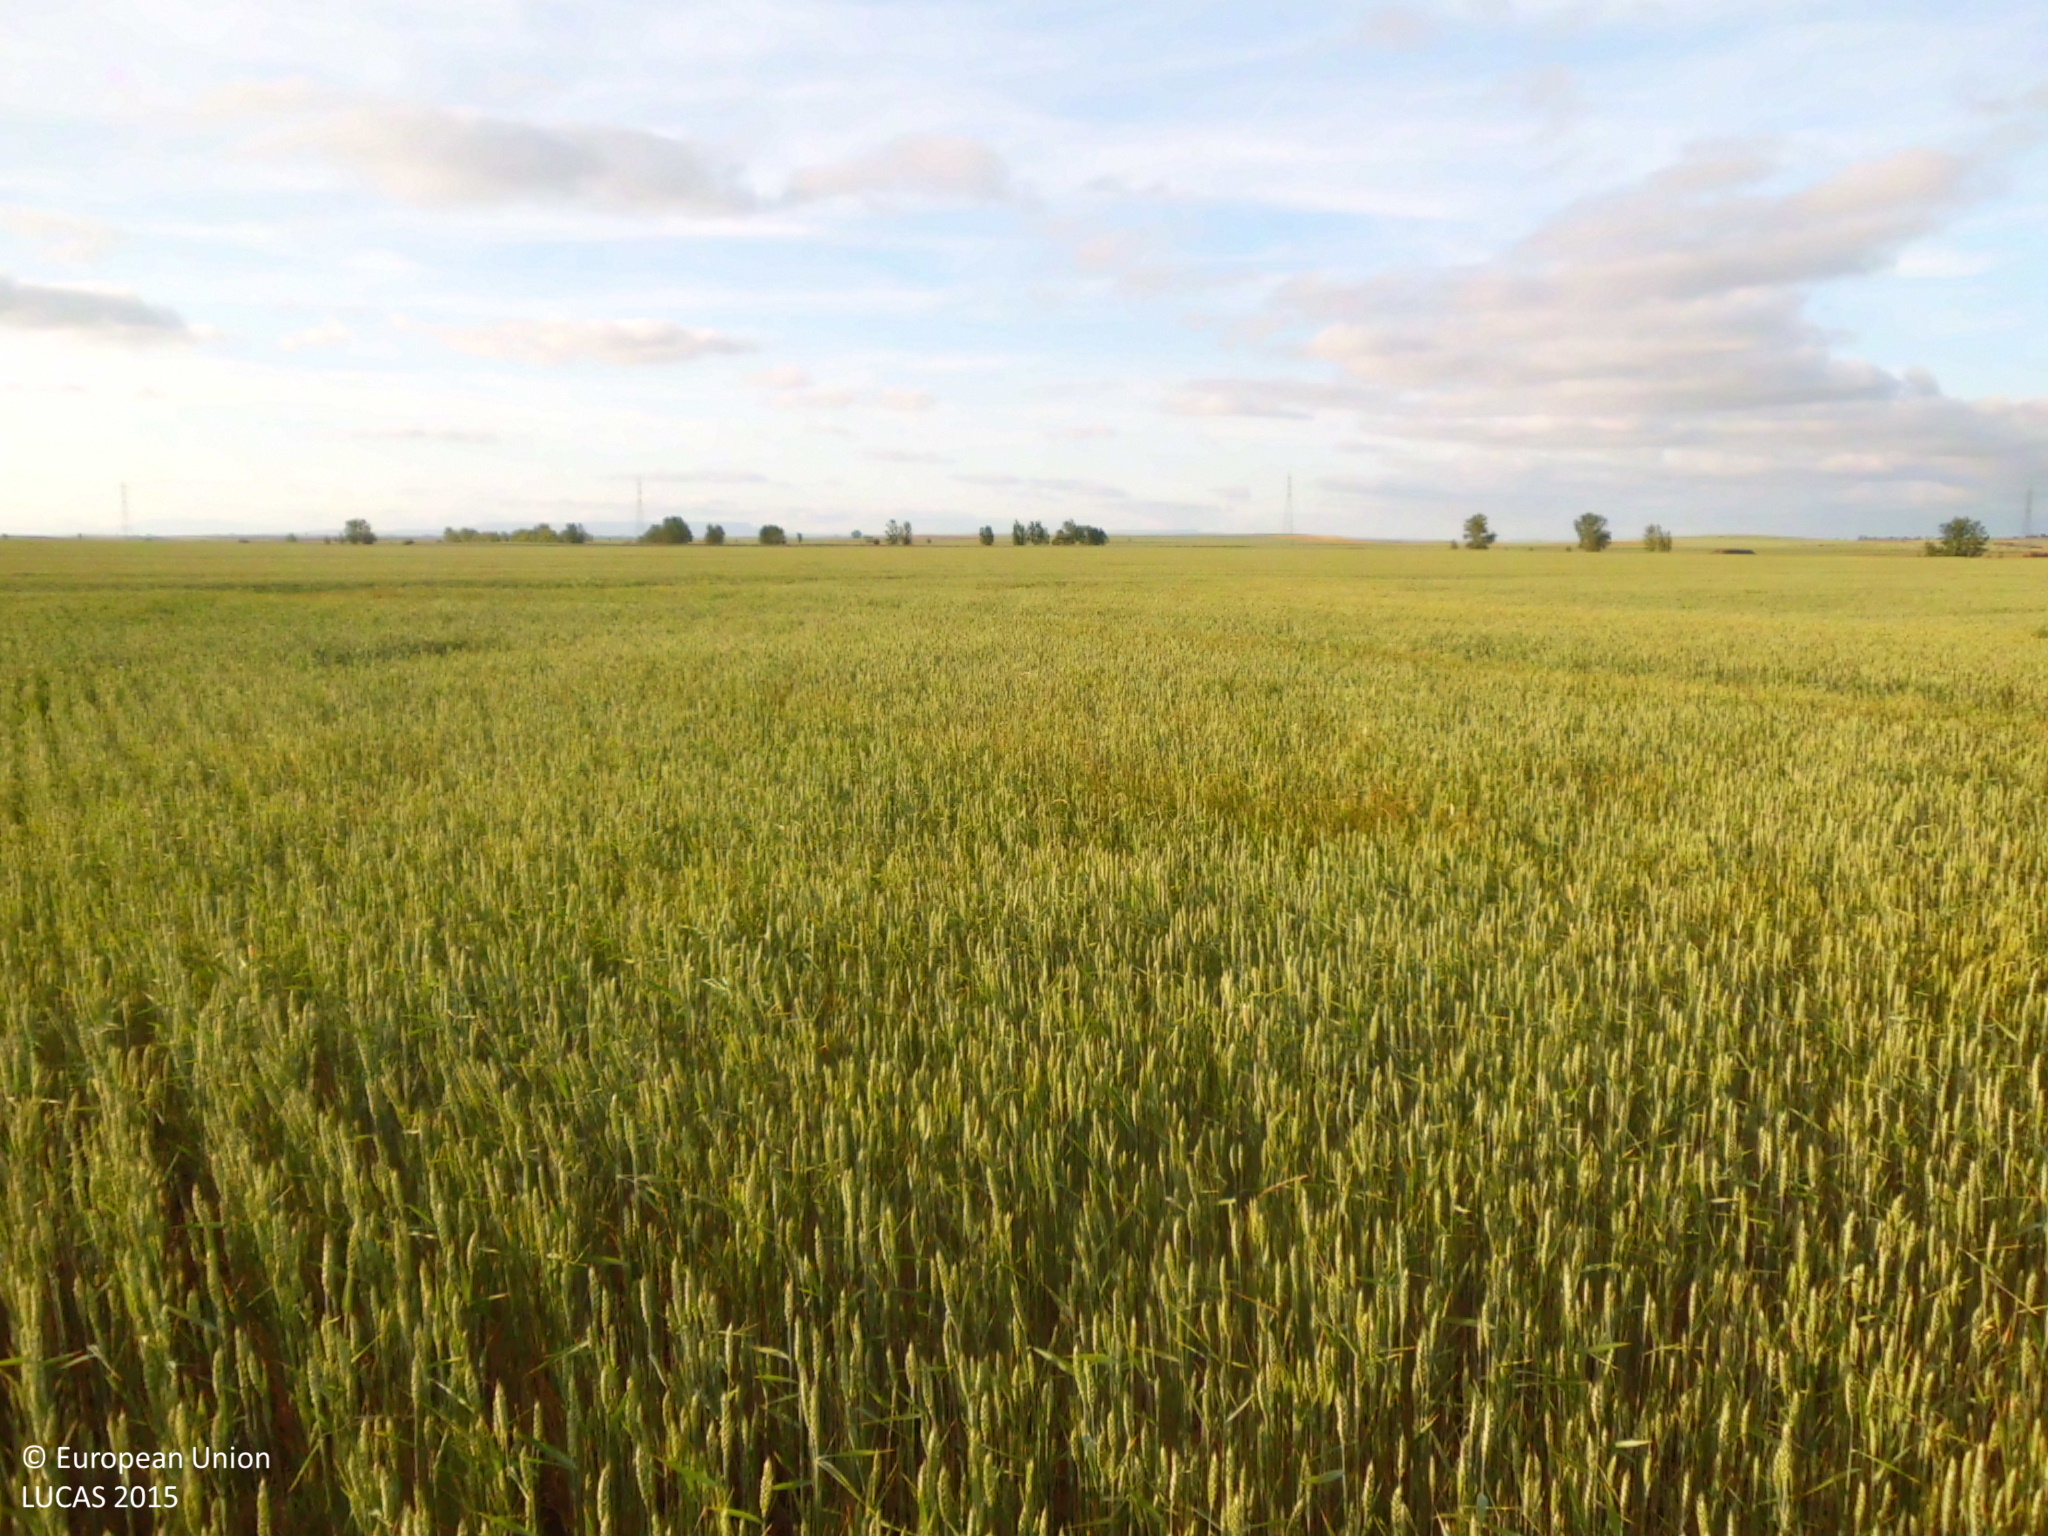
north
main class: Cropland
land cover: Common wheat
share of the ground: > 75 %
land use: Agriculture (excluding fallow land and kitchen gardens)
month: May
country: ES
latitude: 42.3455
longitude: -4.1856
